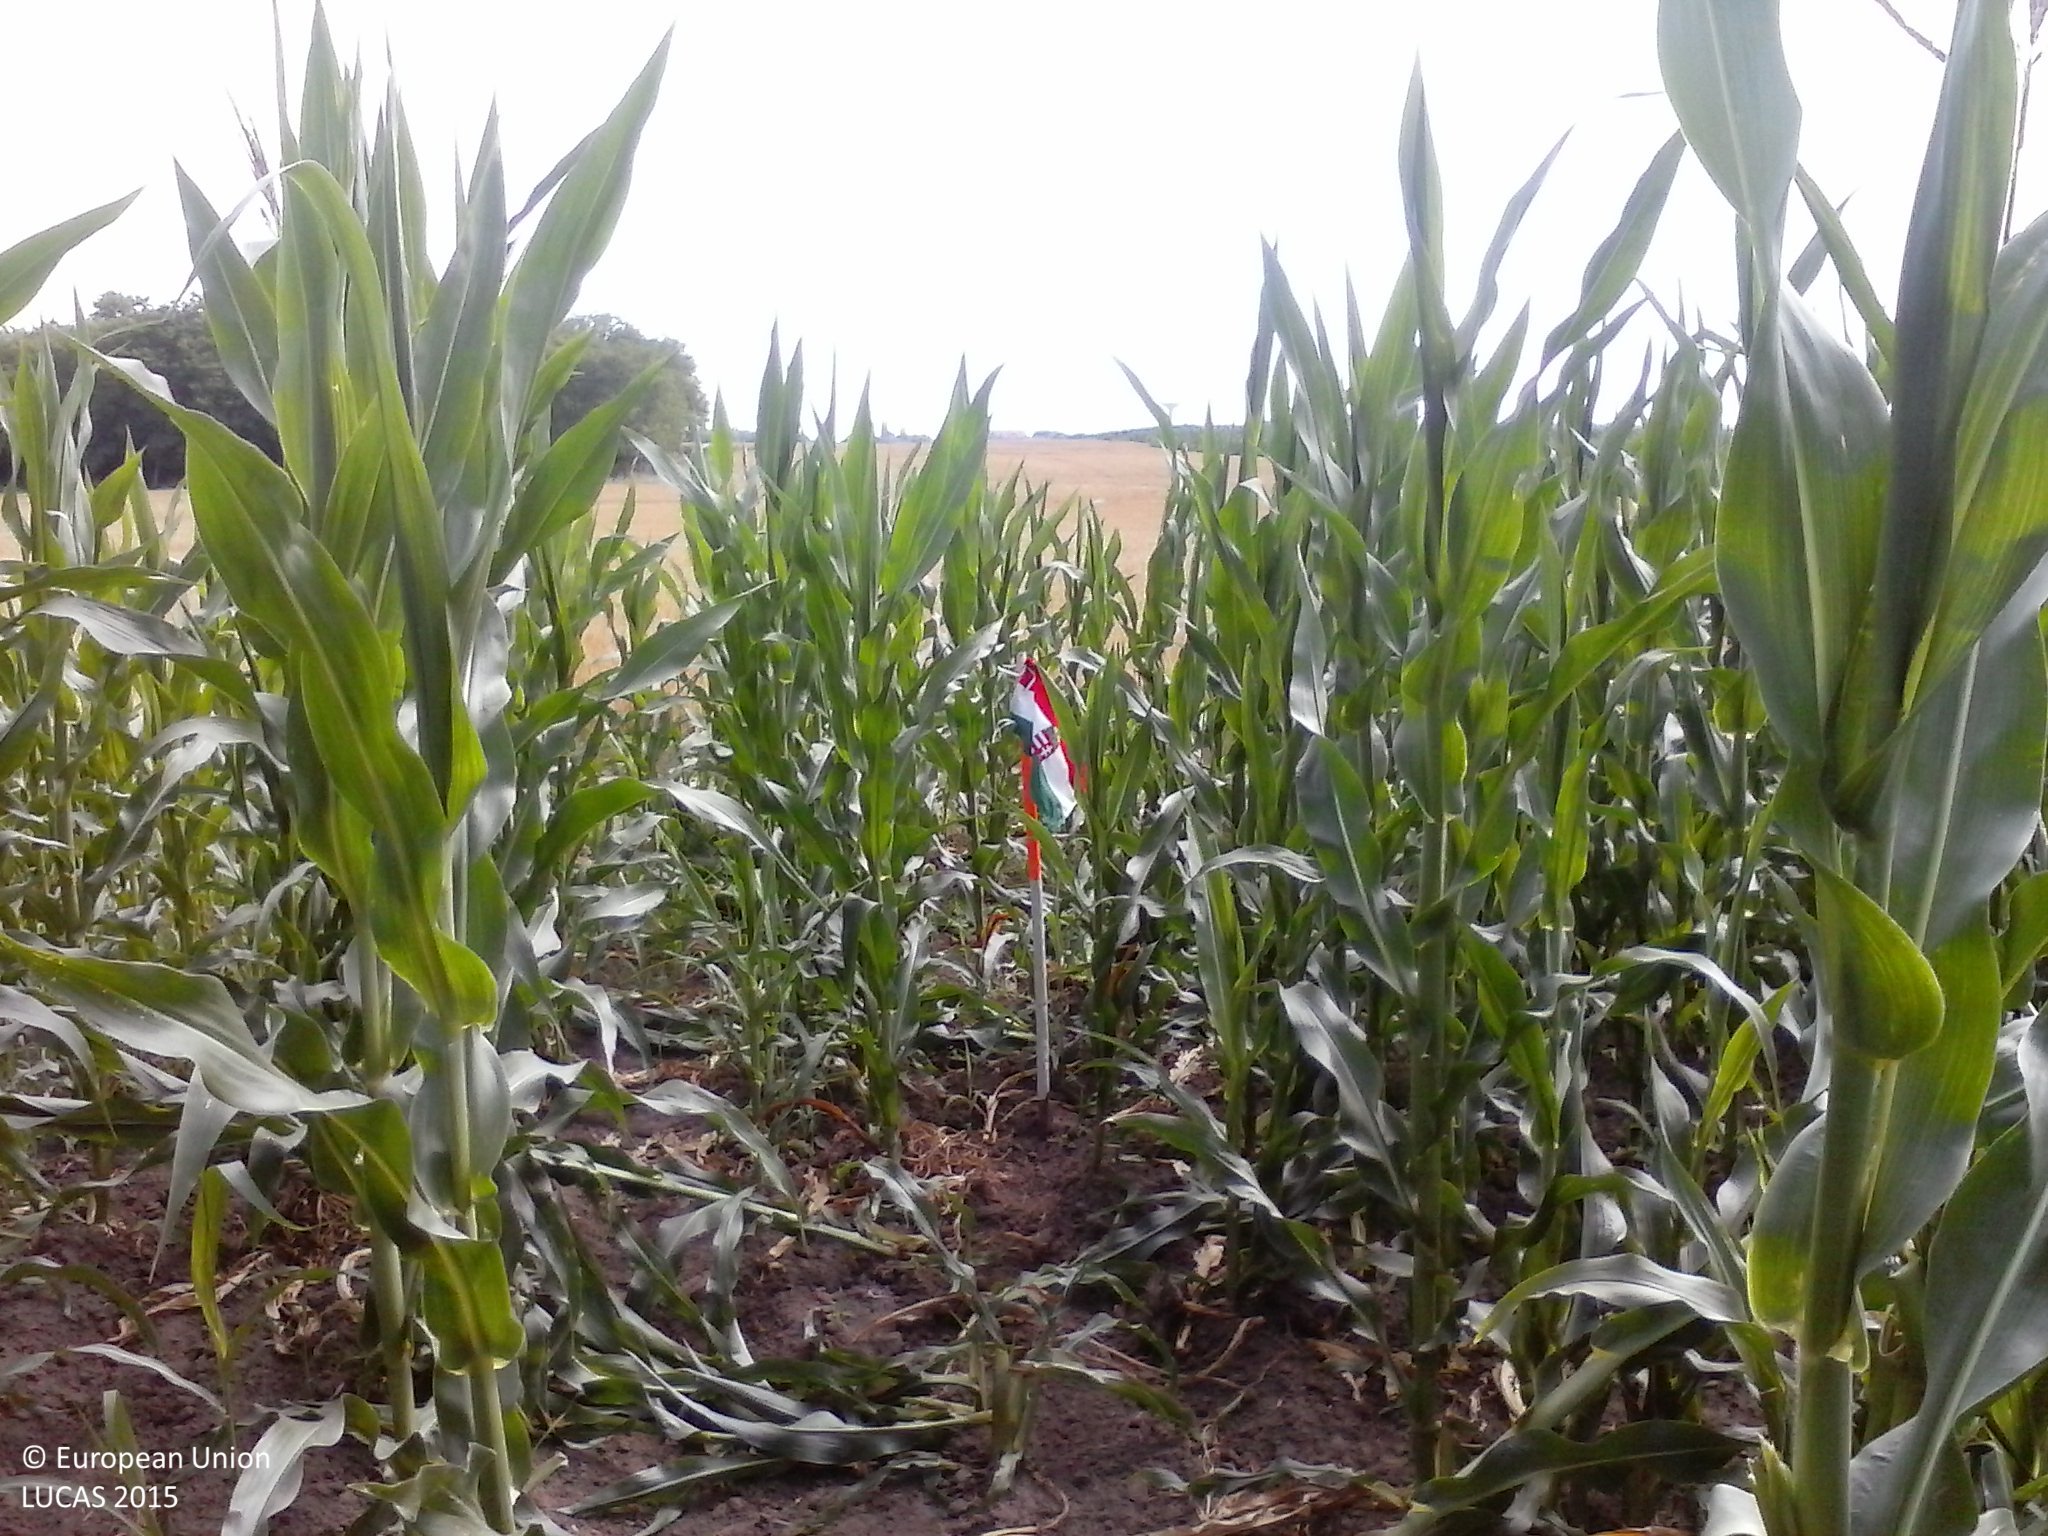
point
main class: Cropland
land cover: Maize
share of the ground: > 75 %
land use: Agriculture (excluding fallow land and kitchen gardens)
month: June
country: HU
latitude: 46.1981
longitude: 19.5150
